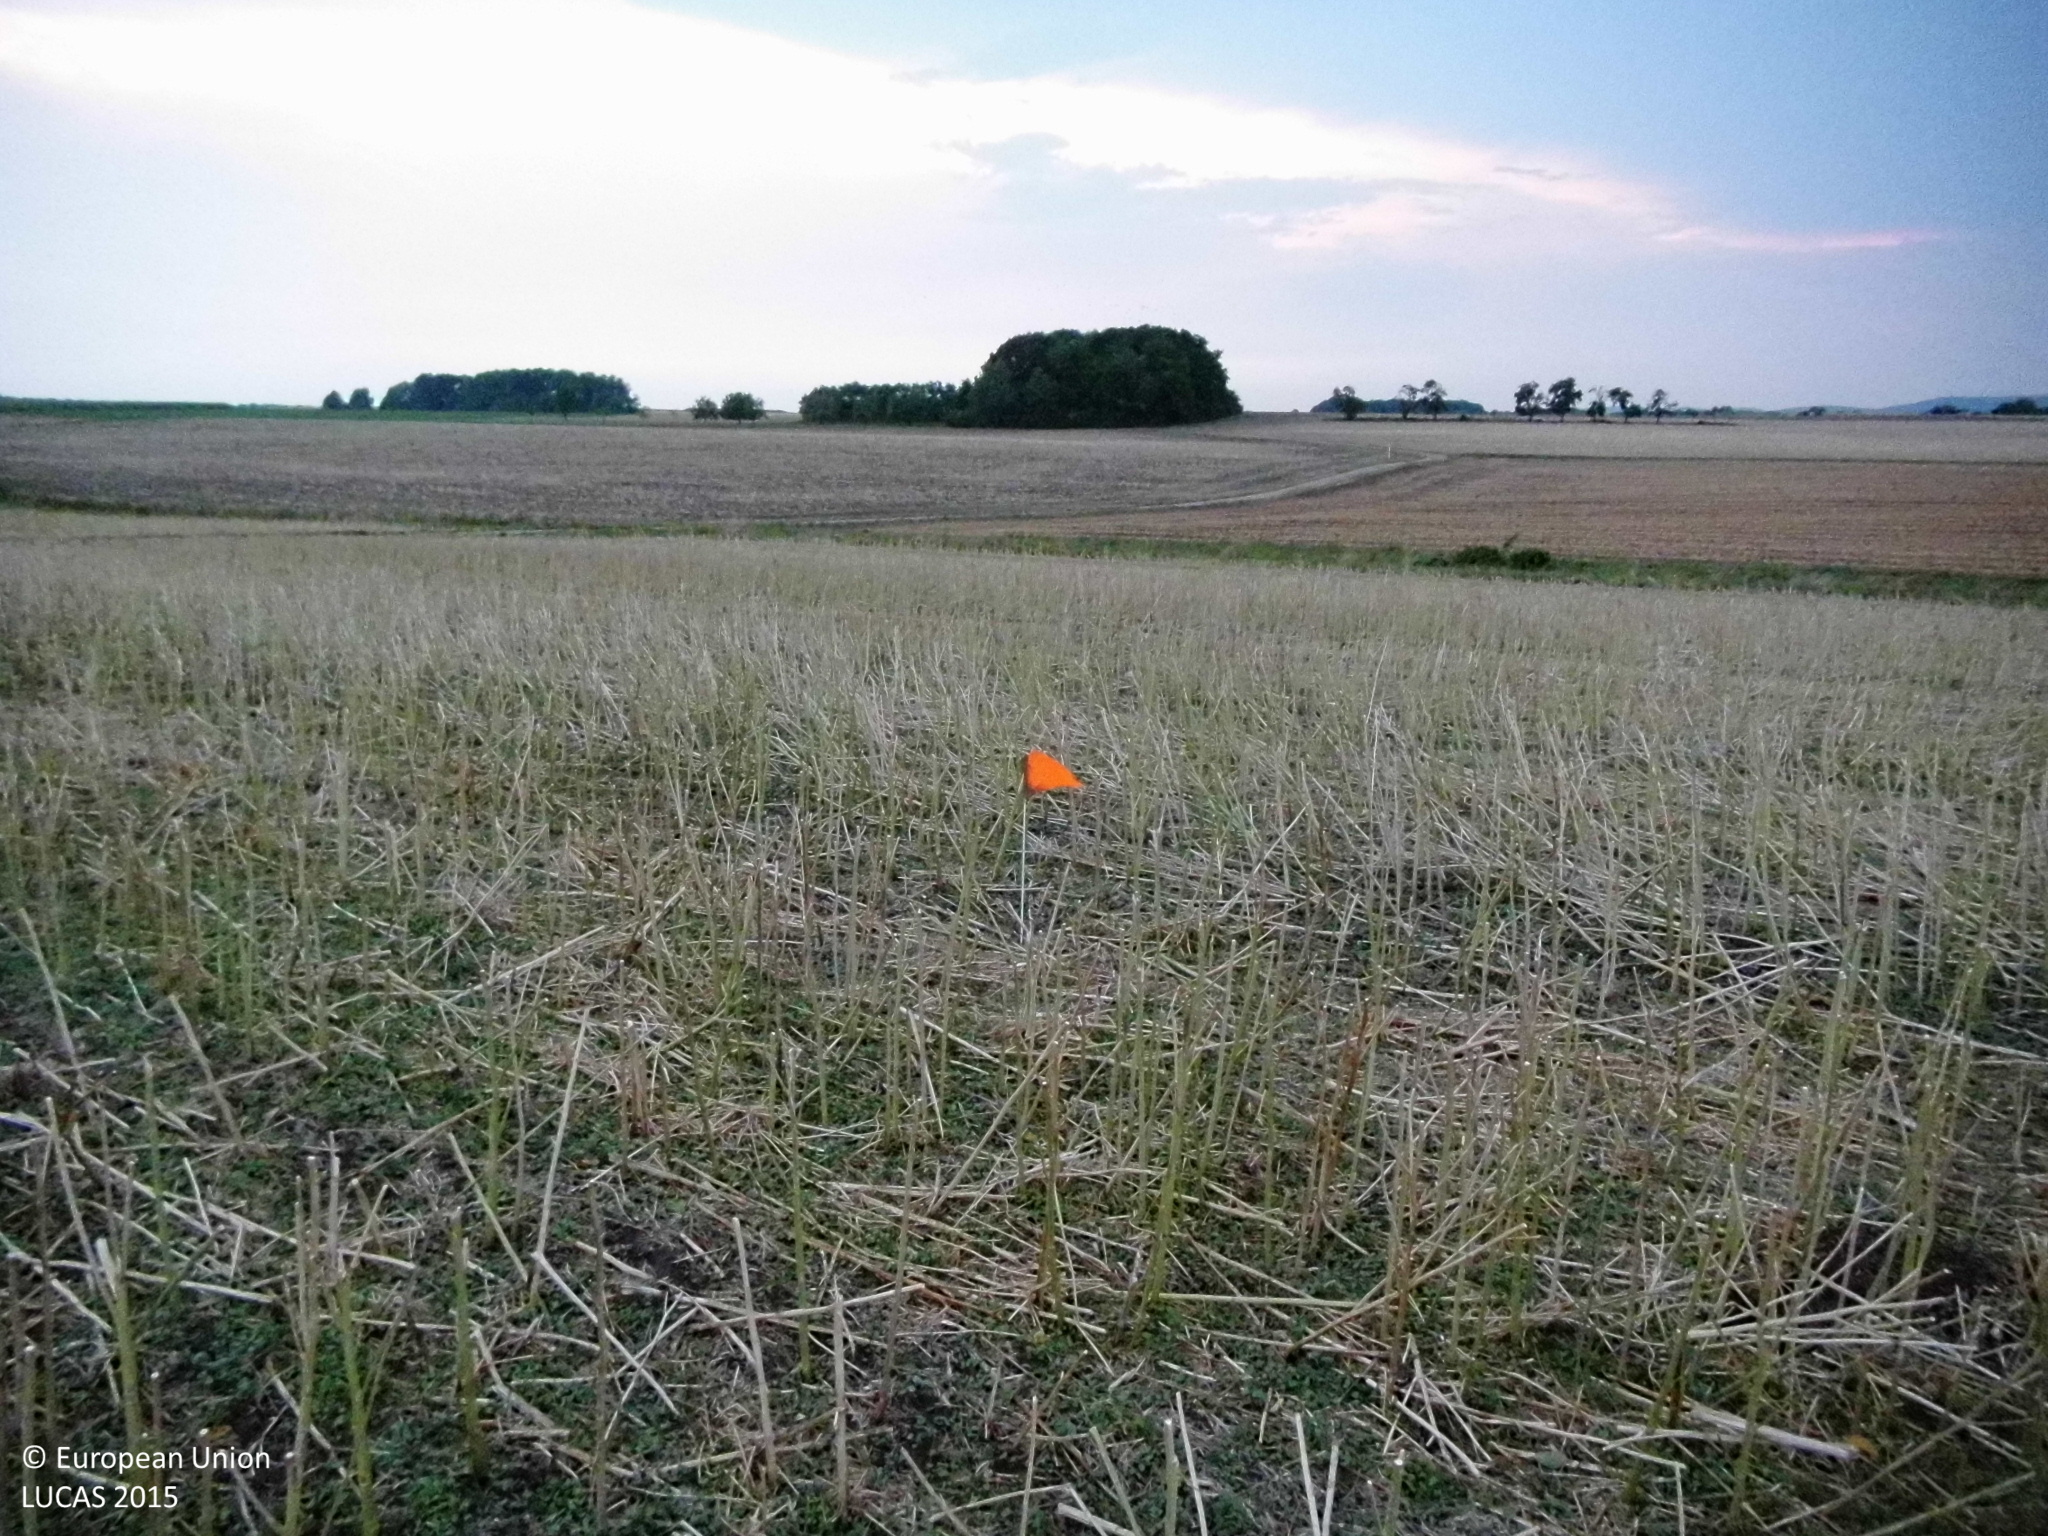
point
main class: Cropland
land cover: Rape and turnip rape
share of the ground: > 75 %
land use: Agriculture (excluding fallow land and kitchen gardens)
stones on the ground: < 10 %
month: August
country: DE
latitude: 50.5354
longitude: 8.6036
